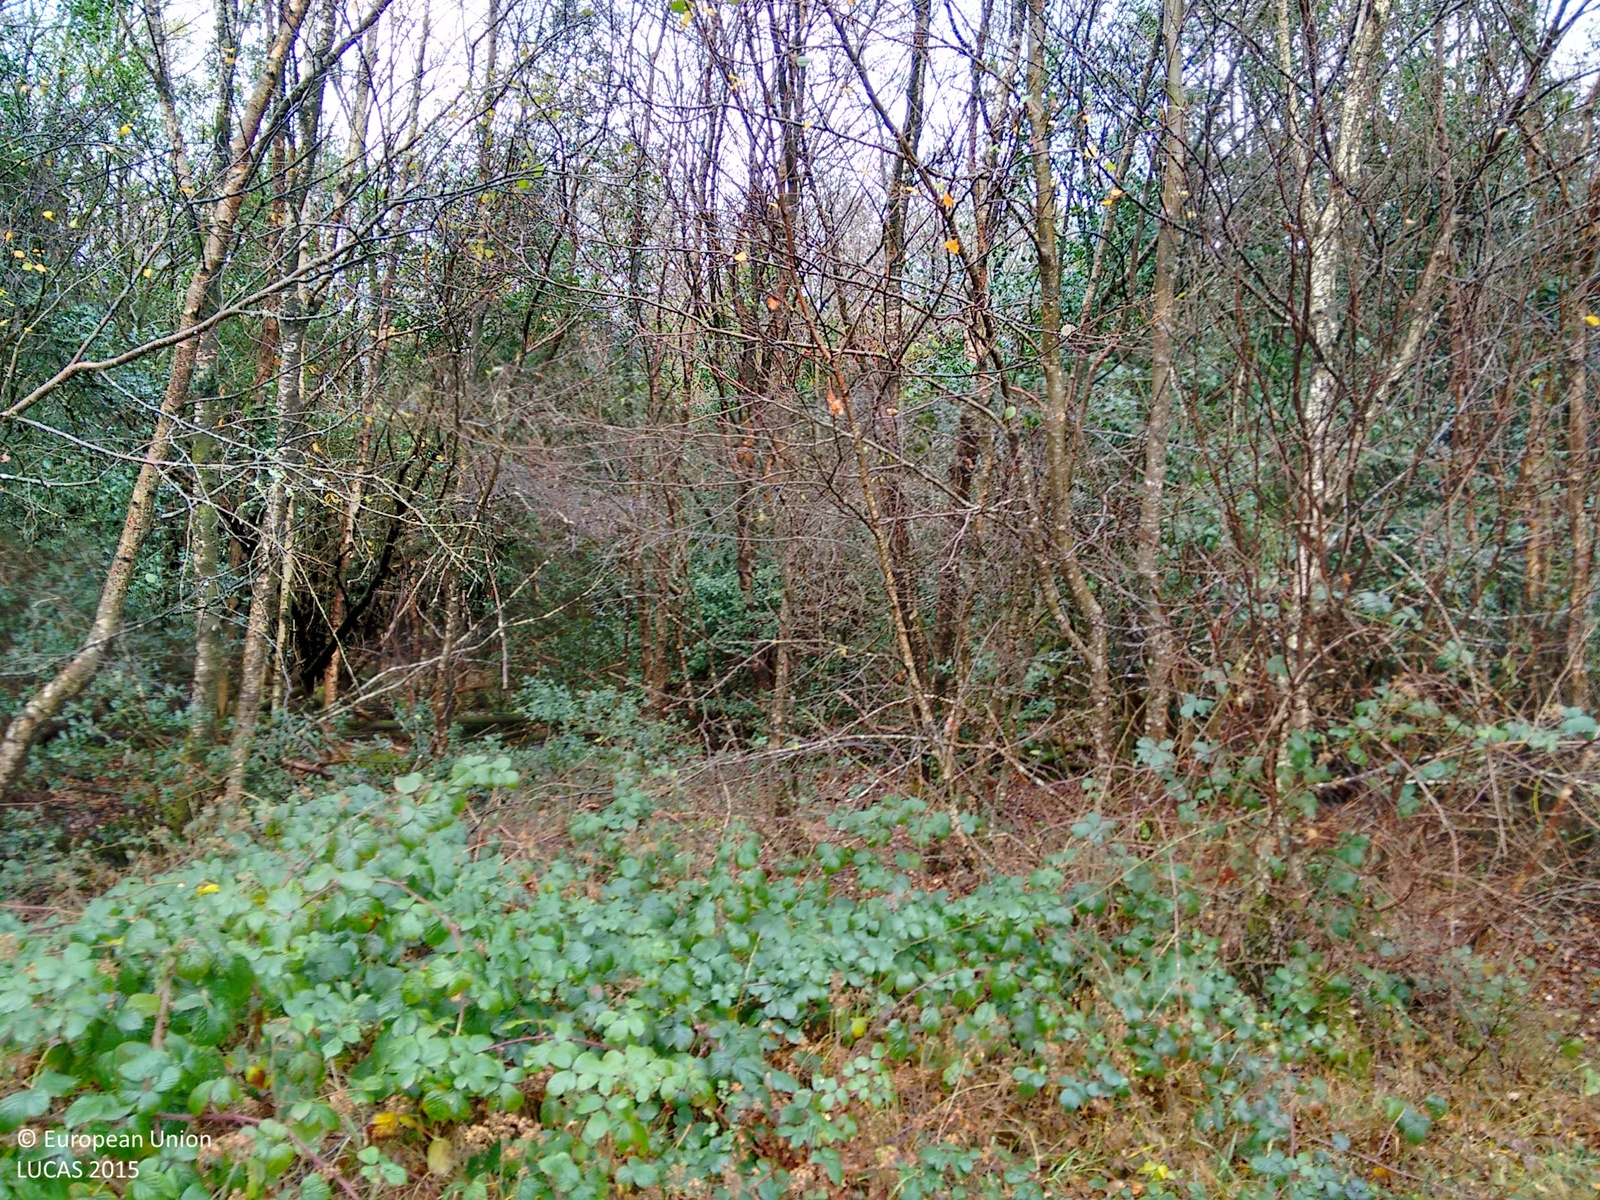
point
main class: Woodland
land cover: Broadleaved woodland
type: mesophytic deciduous forest
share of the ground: > 75 %
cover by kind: broadleaved forest trees 60 %, herbaceous plants 40 %
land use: Agriculture (excluding fallow land and kitchen gardens)
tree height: > 5 m
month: November
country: IE
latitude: 54.3436
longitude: -8.0020
